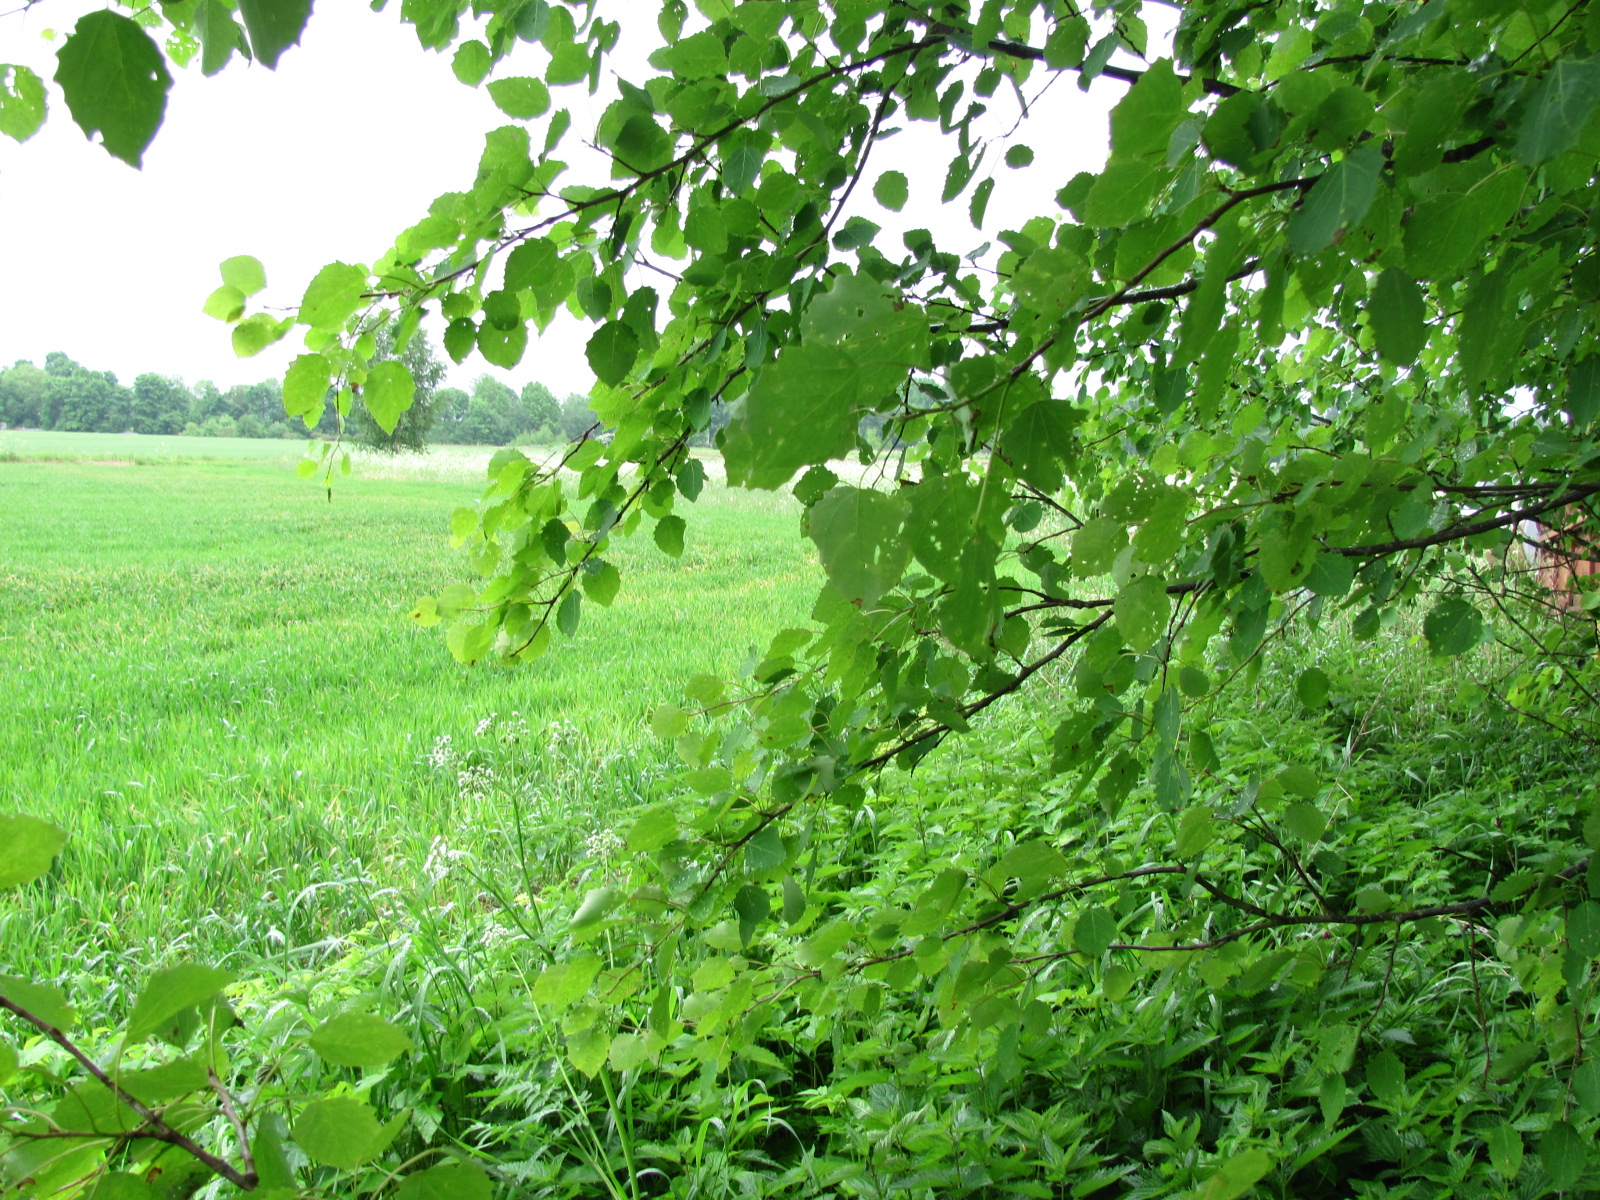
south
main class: Woodland
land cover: Broadleaved woodland
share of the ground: > 75 %
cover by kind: broadleaved forest trees 100 %
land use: Residential
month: June
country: LV
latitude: 56.5951
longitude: 24.2425
